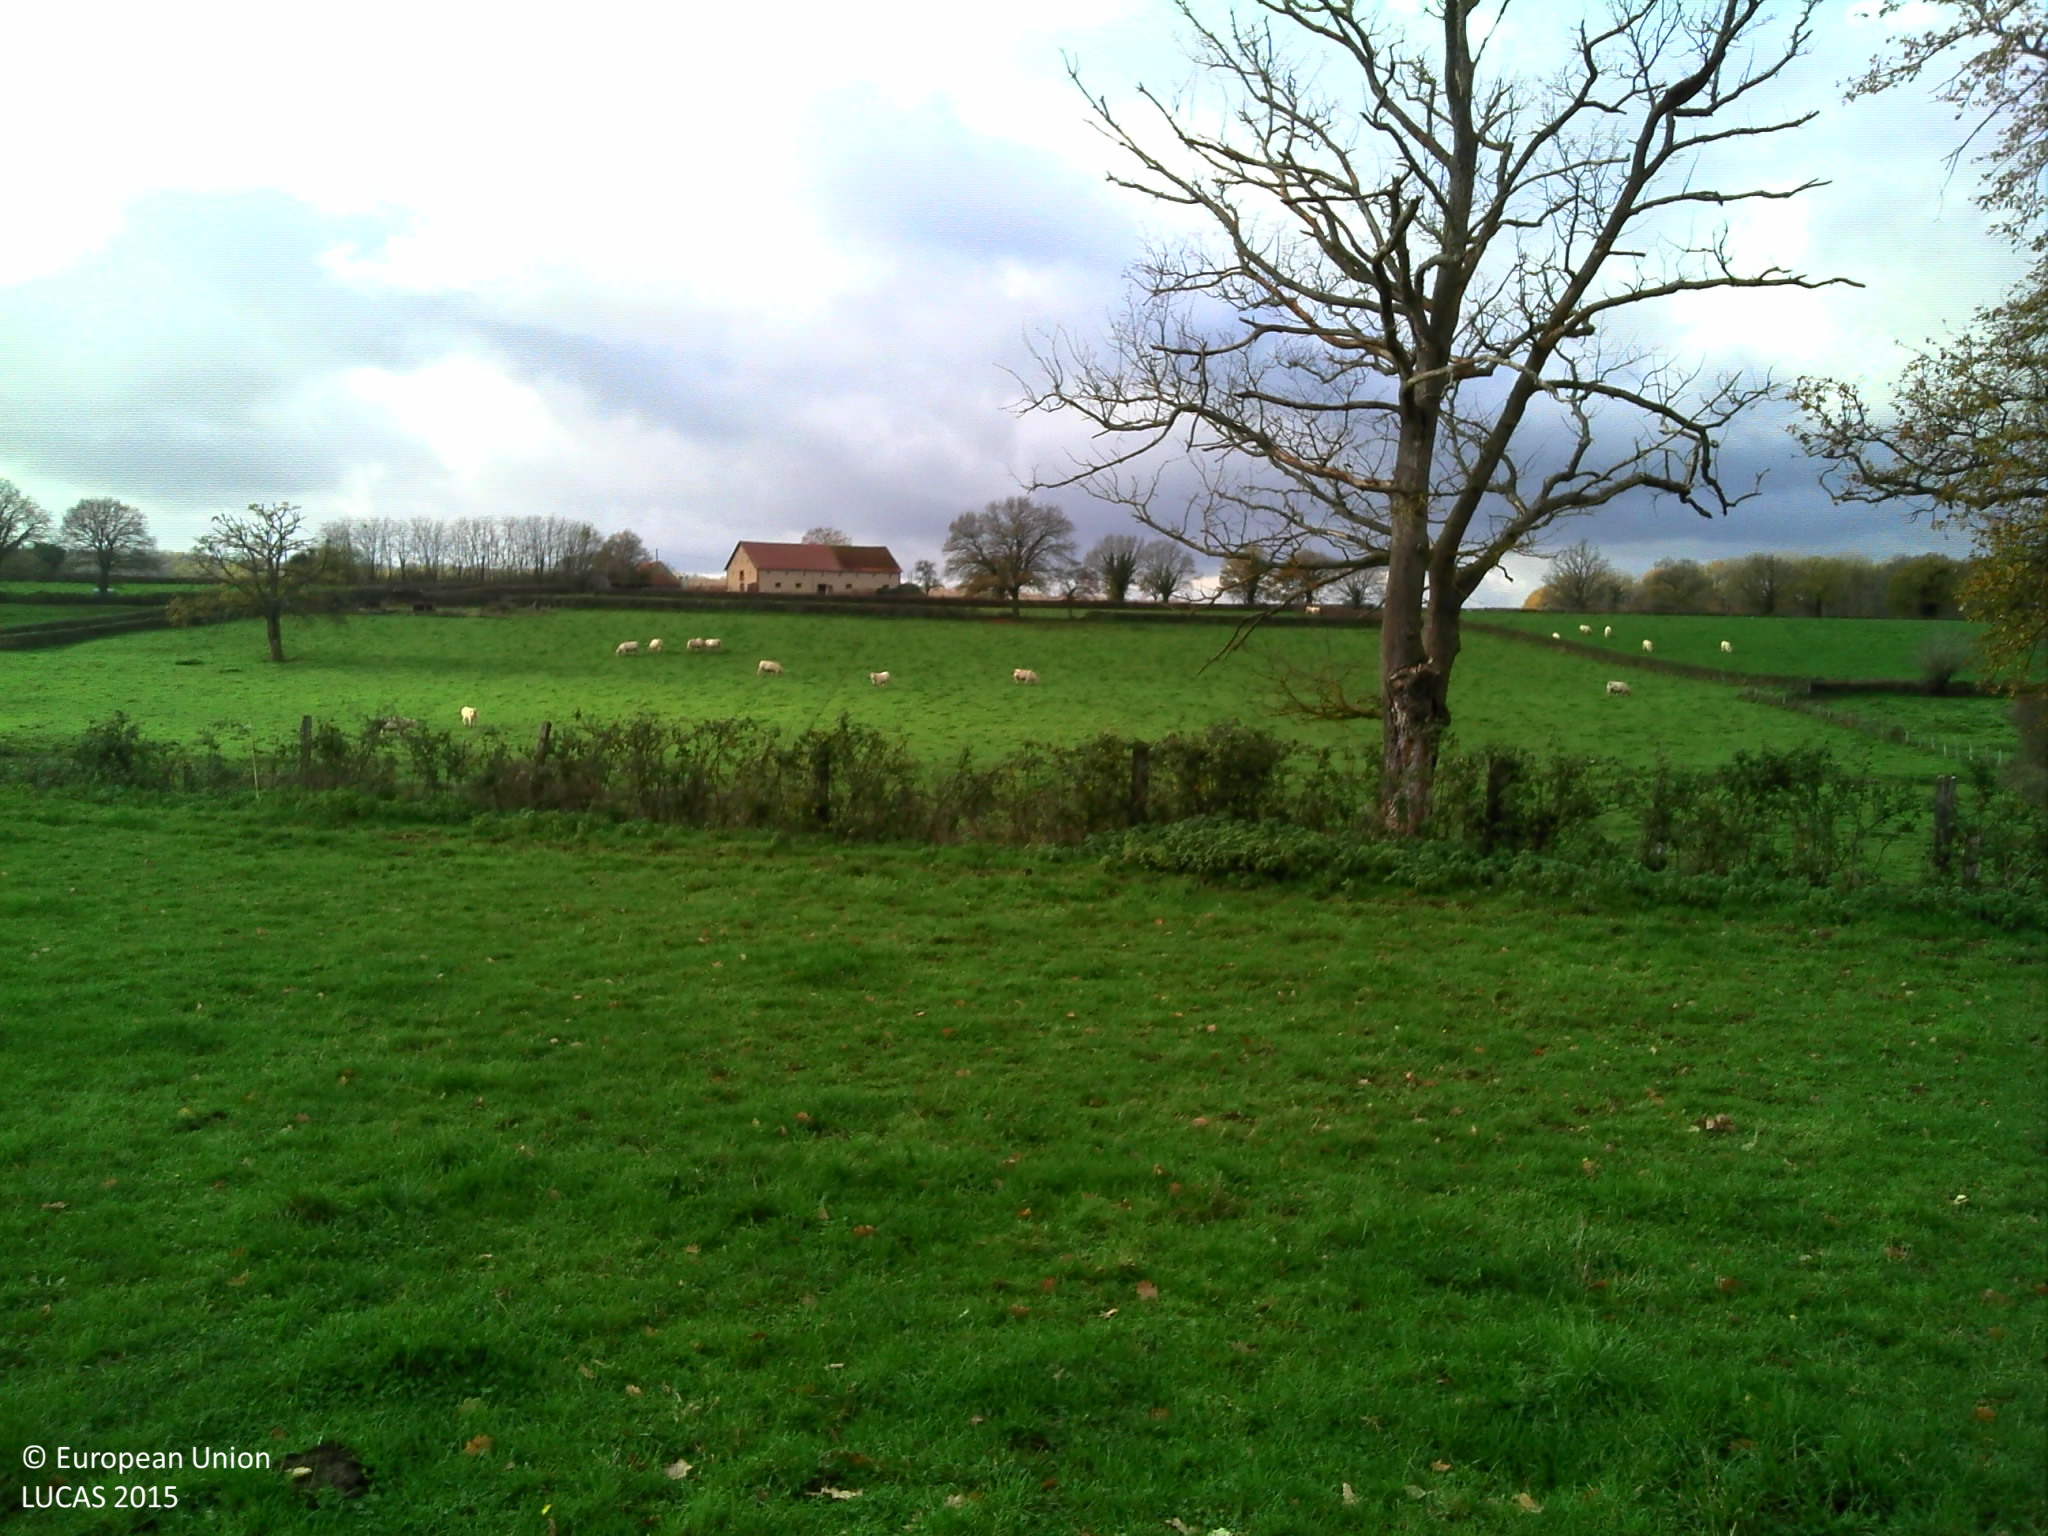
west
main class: Grassland
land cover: Grassland without tree/shrub cover
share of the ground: > 75 %
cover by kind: herbaceous plants 100 %
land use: Agriculture (excluding fallow land and kitchen gardens)
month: November
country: FR
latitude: 46.4177
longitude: 3.6895
